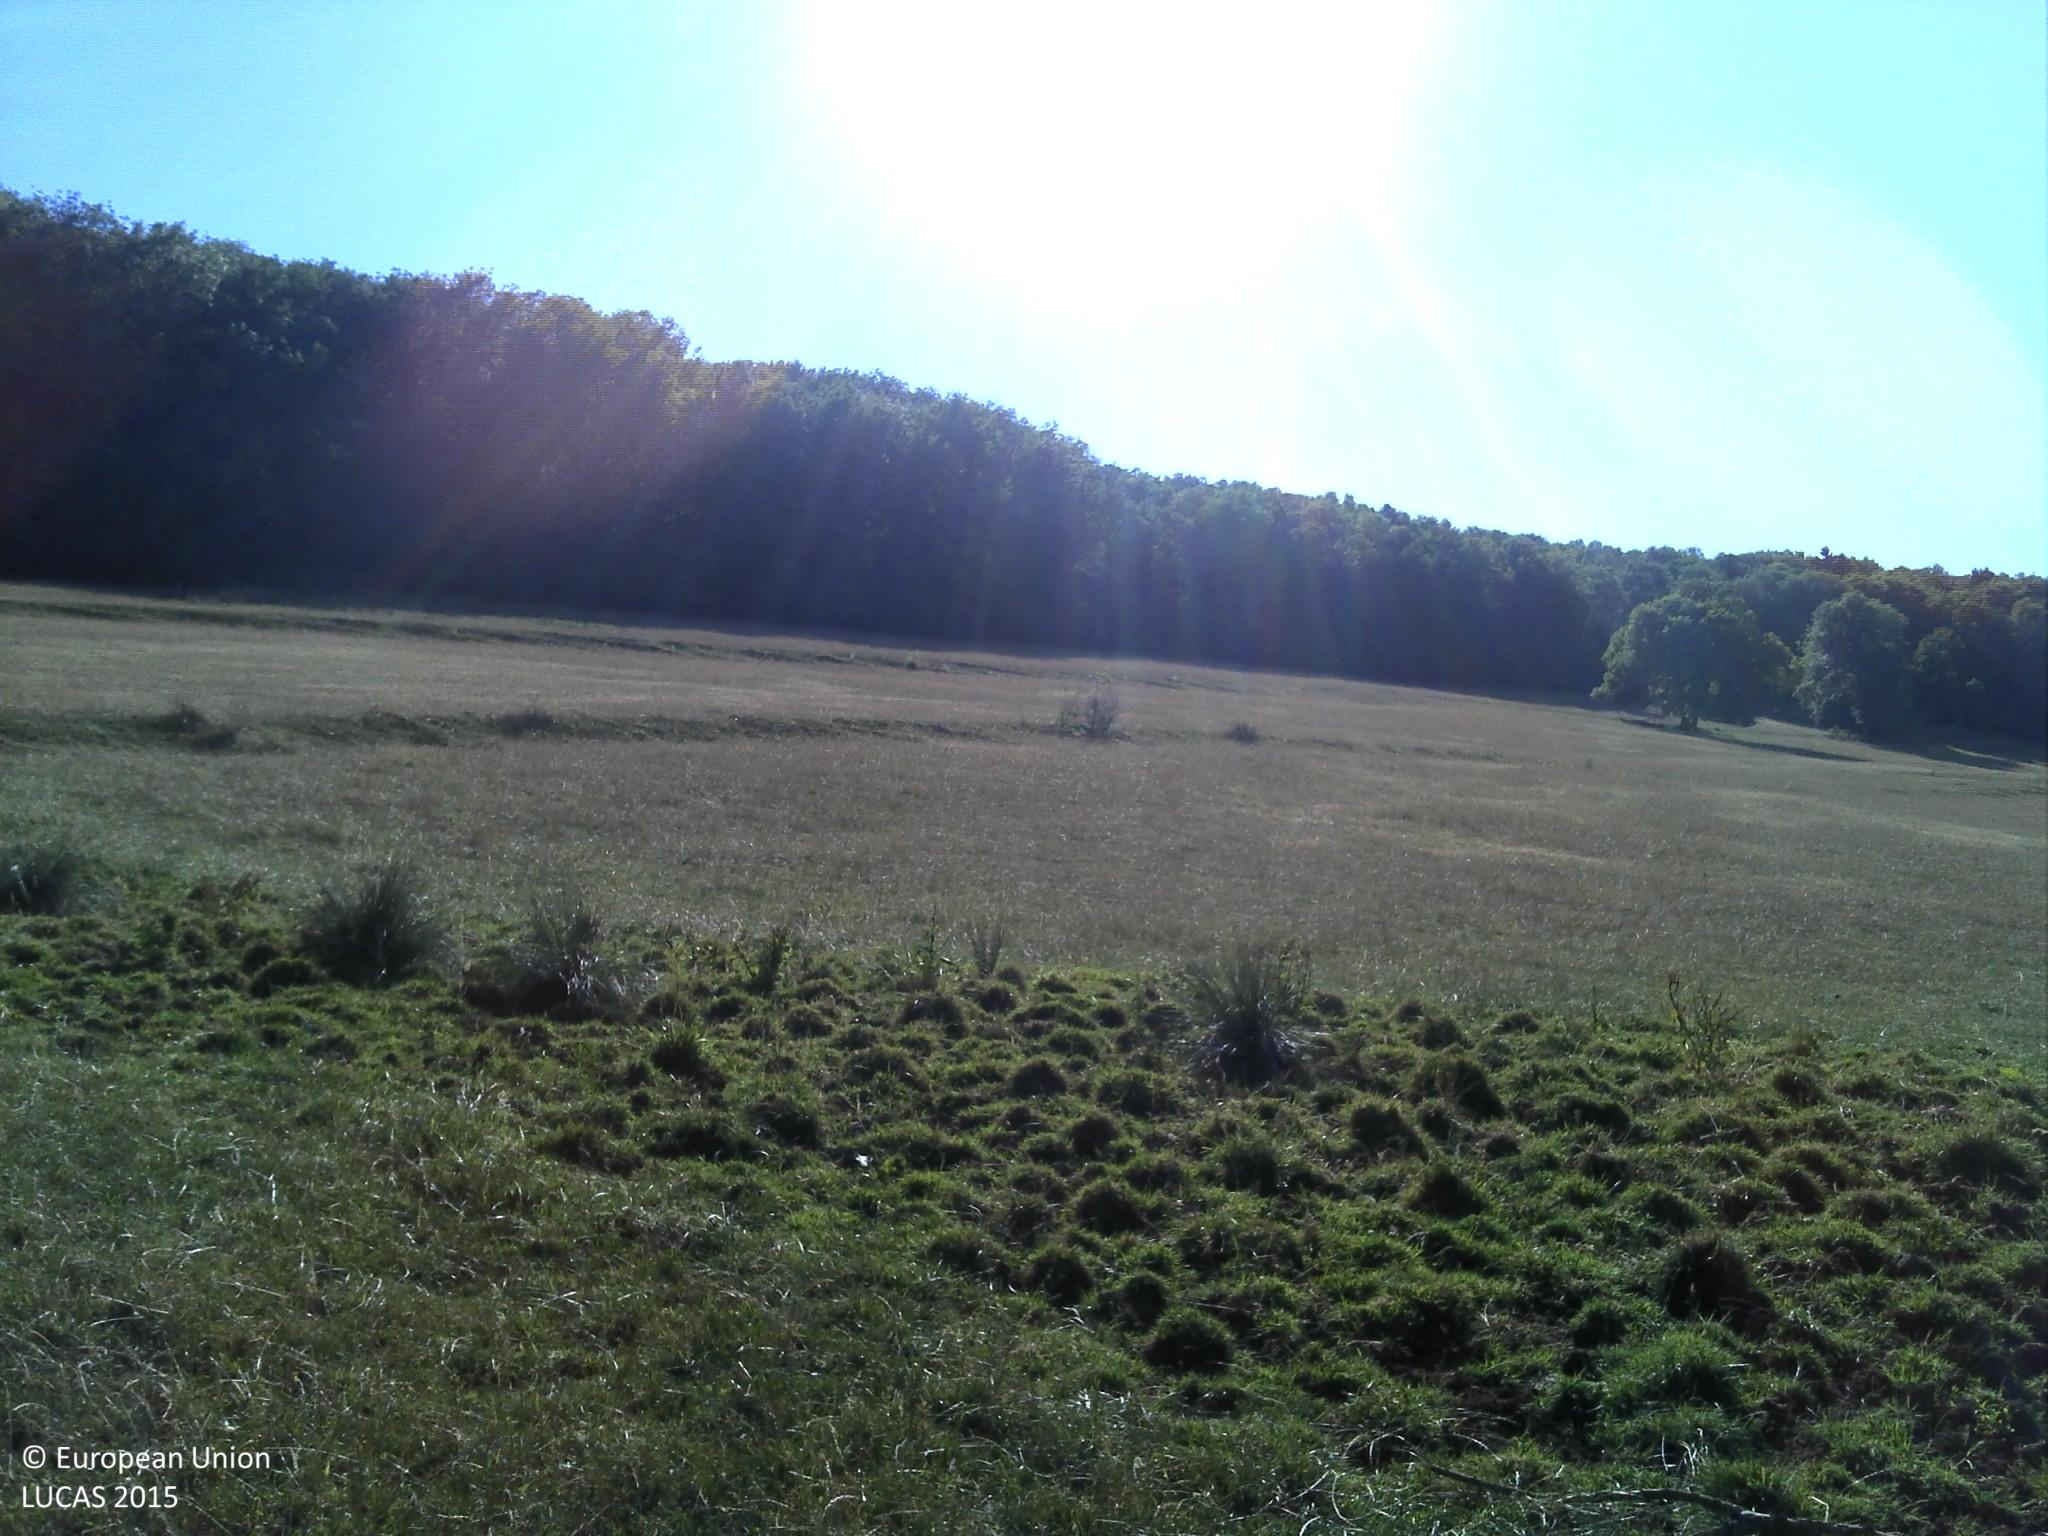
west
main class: Grassland
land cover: Grassland without tree/shrub cover
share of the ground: > 75 %
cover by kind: herbaceous plants 100 %
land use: Agriculture (excluding fallow land and kitchen gardens)
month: July
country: FR
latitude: 49.6846
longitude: 4.7437
